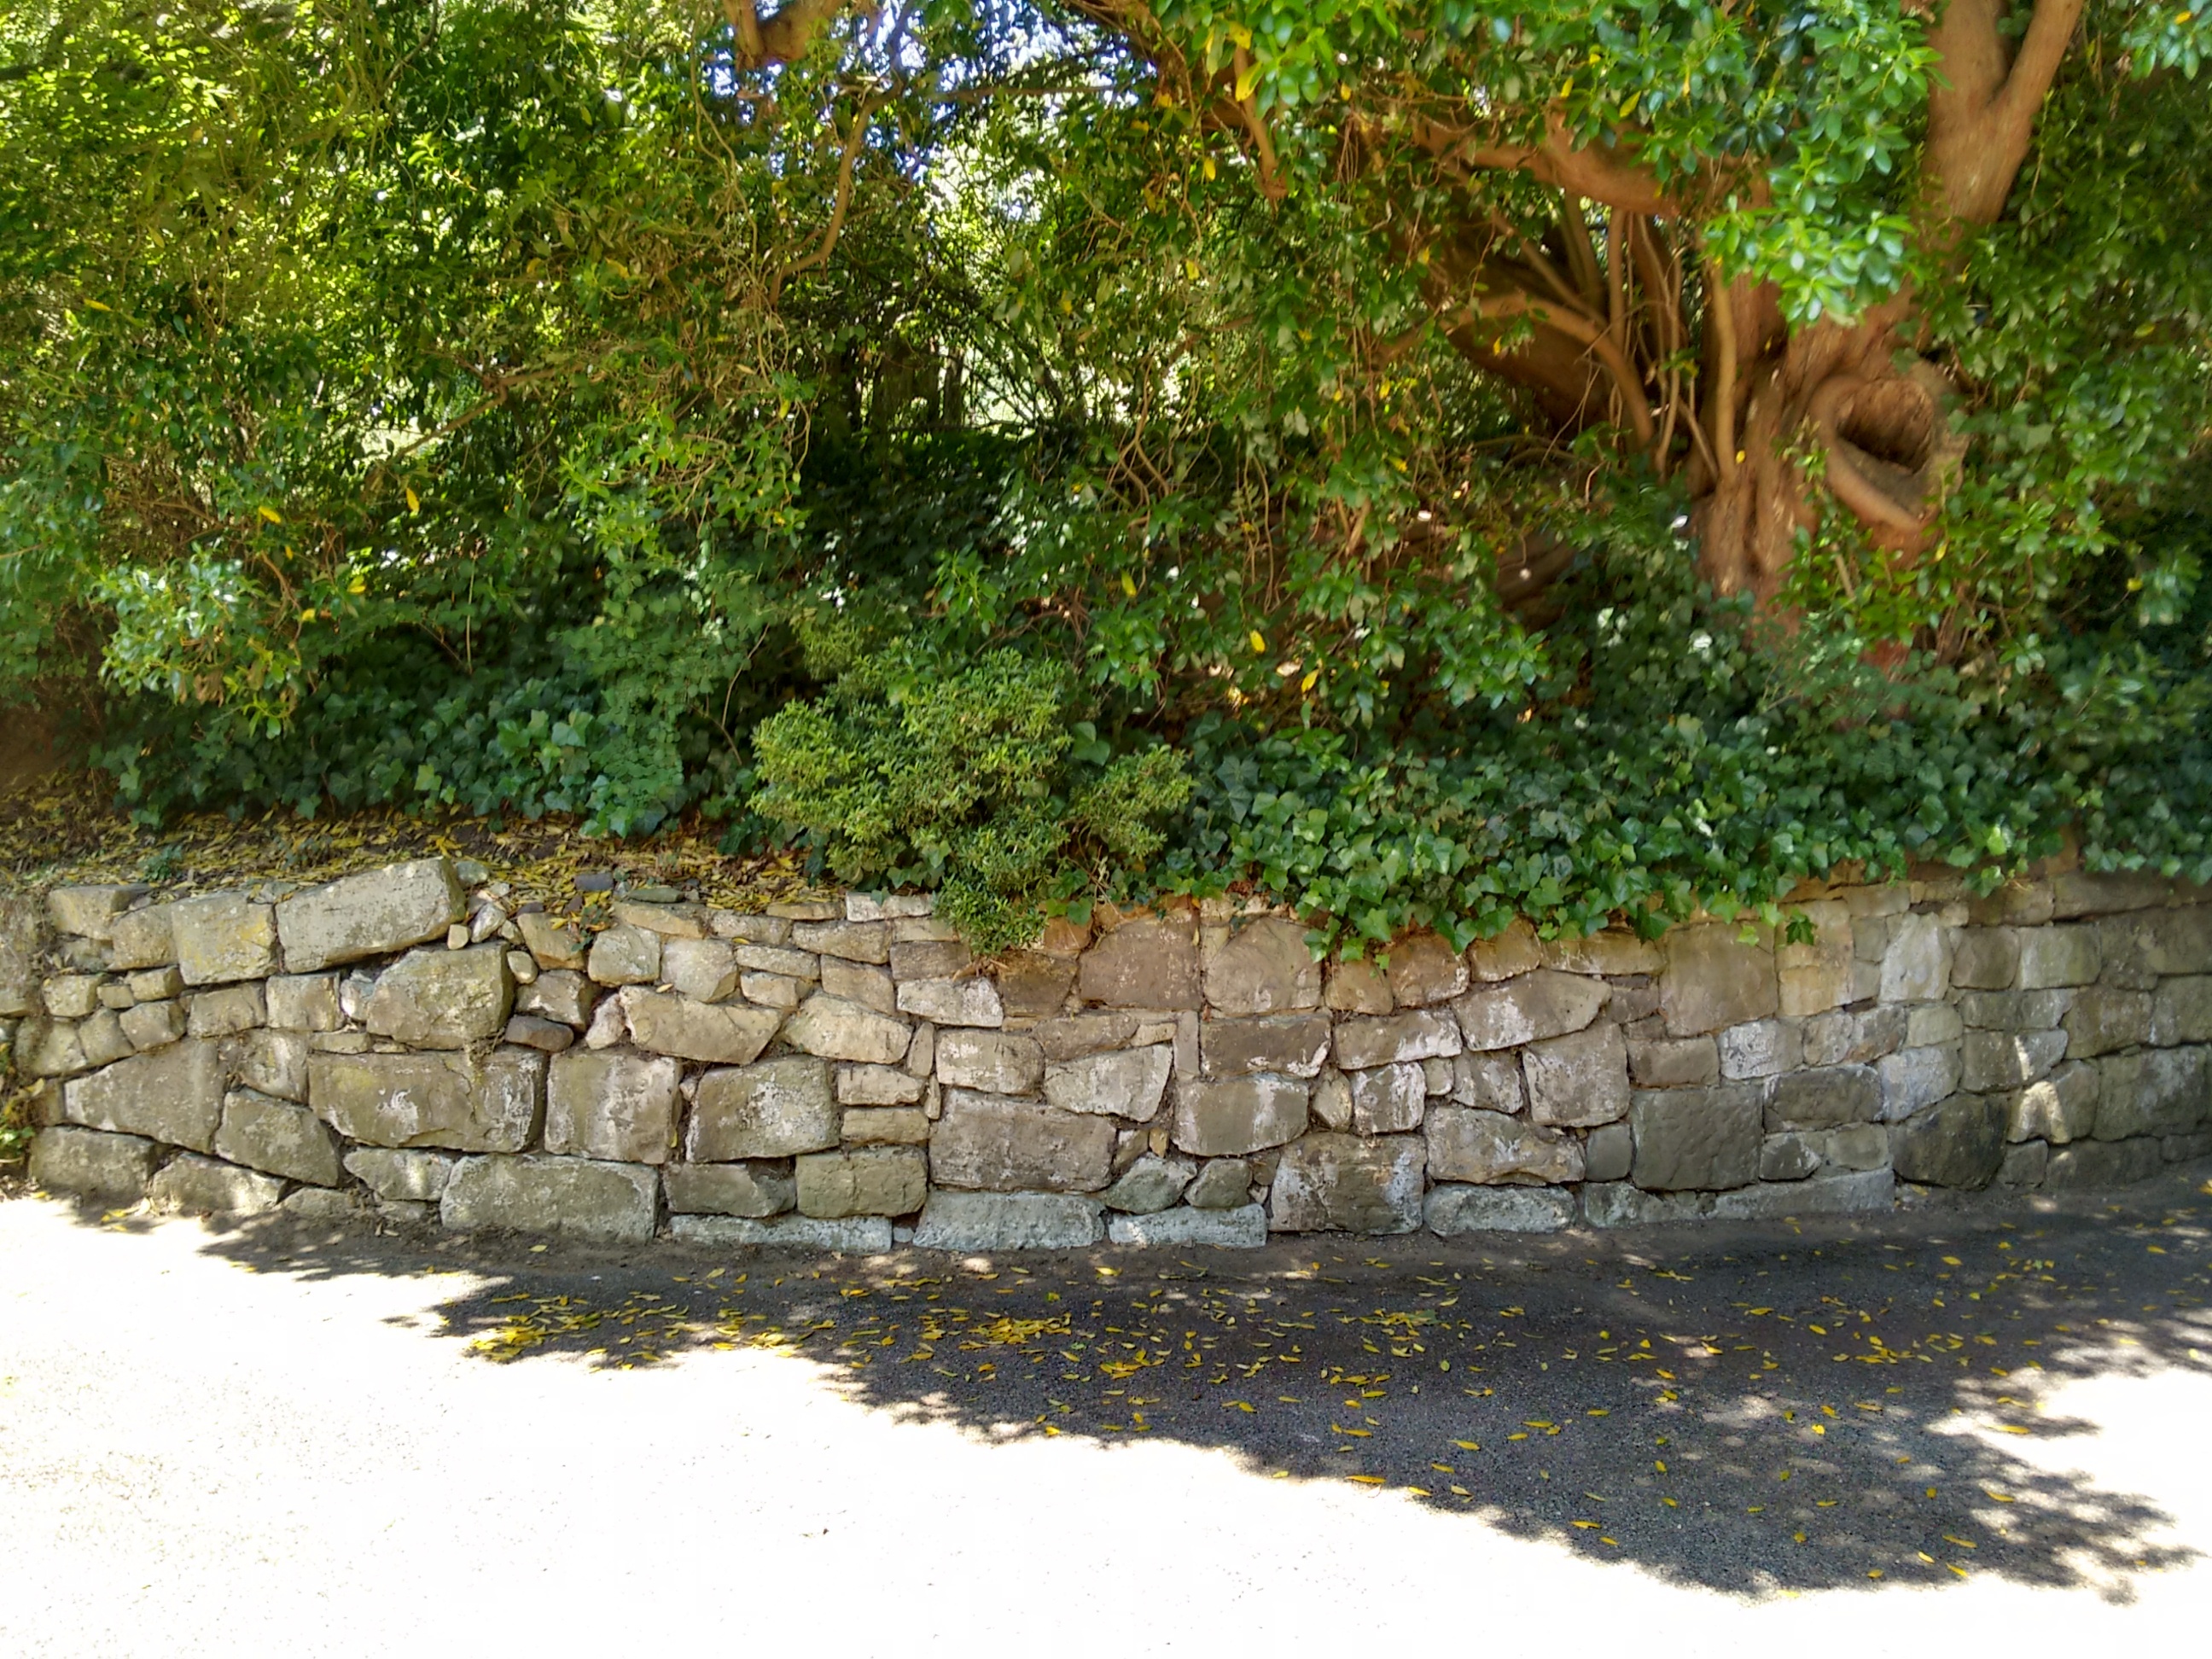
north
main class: Grassland
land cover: Grassland with sparse tree/shrub cover
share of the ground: > 75 %
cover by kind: herbaceous plants 85 %, shrubs 10 %, broadleaved forest trees 5 %
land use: Residential
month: June
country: GB
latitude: 51.2286
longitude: -0.2170
